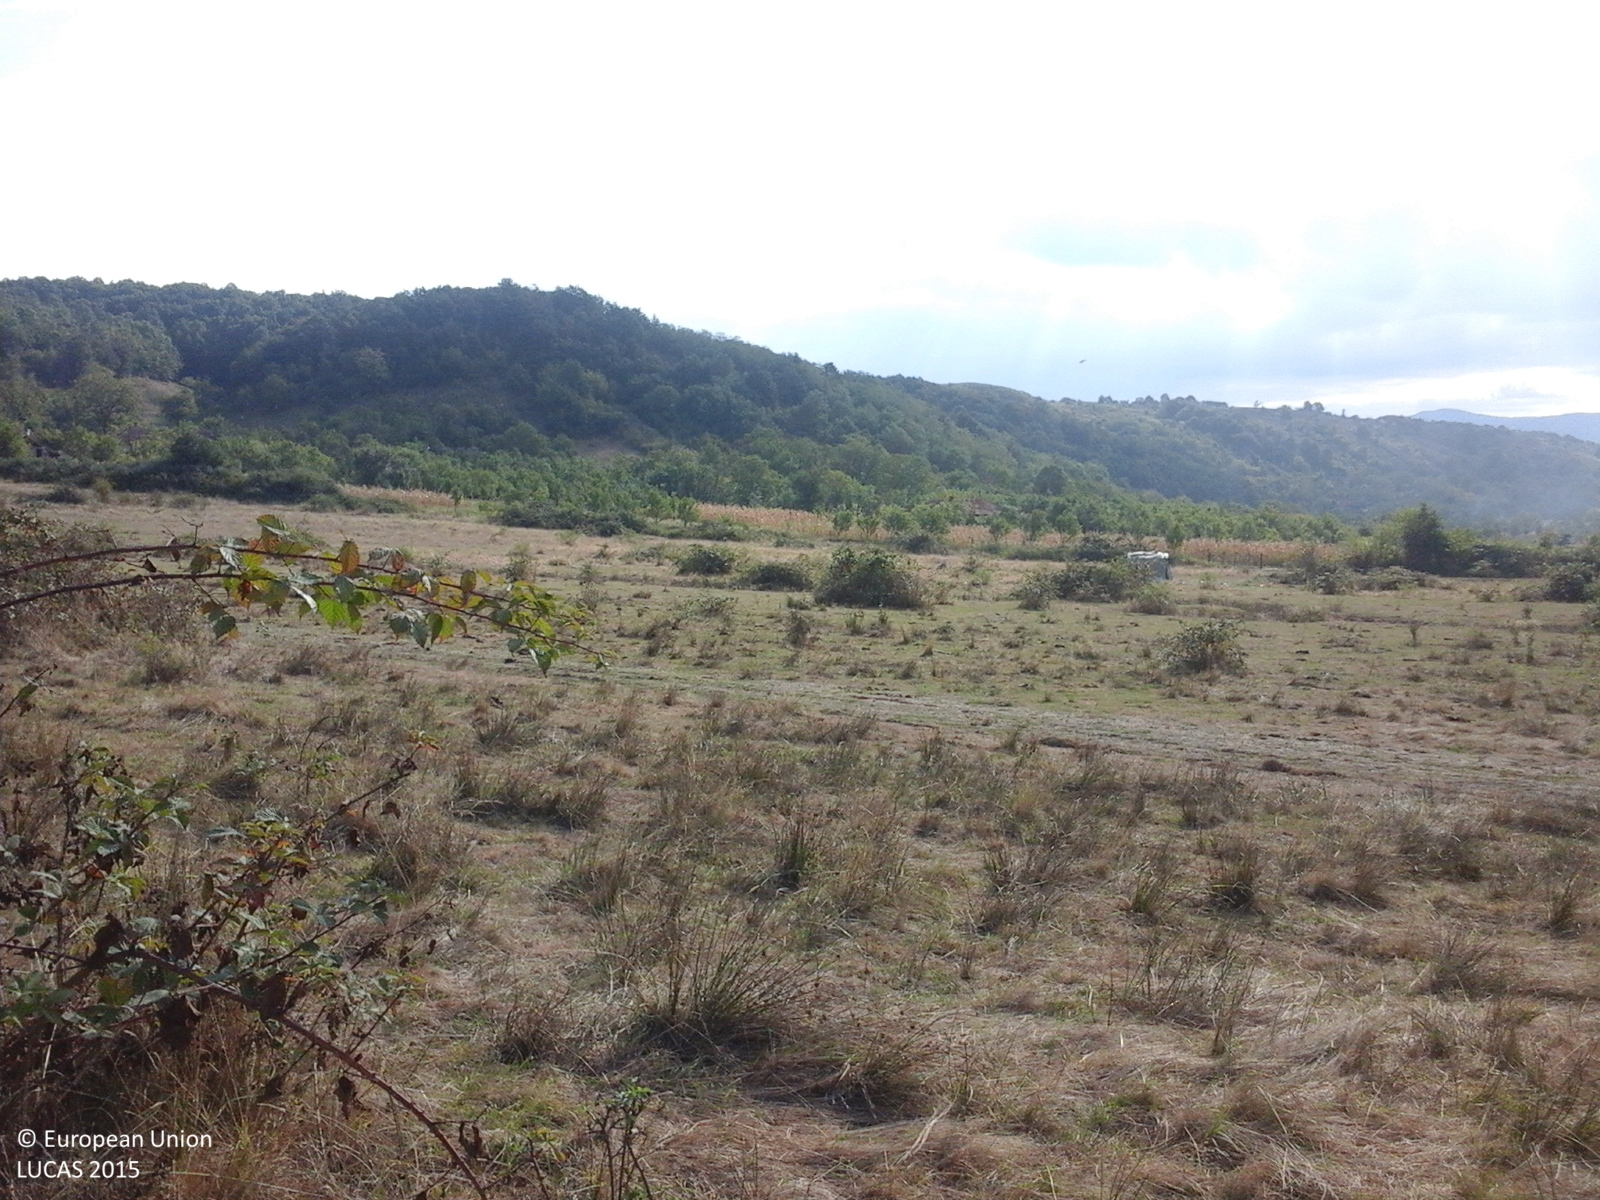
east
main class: Grassland
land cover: Grassland with sparse tree/shrub cover
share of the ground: > 75 %
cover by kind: herbaceous plants 85 %, shrubs 10 %, broadleaved forest trees 5 %
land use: Fallow land
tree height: < 5 m
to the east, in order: Grassland with sparse tree/shrub cover; Grassland without tree/shrub cover; Tracks; Grassland without tree/shrub cover; Ditches and canals; Grassland without tree/shrub cover; Tracks; Spontaneously vegetated surfaces; Tracks; Fences; Abandoned hedges; Grassland without tree/shrub cover; Fences; Grassland without tree/shrub cover; Maize; Other fruit trees and berries
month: September
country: RO
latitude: 47.8201
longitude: 23.2539
